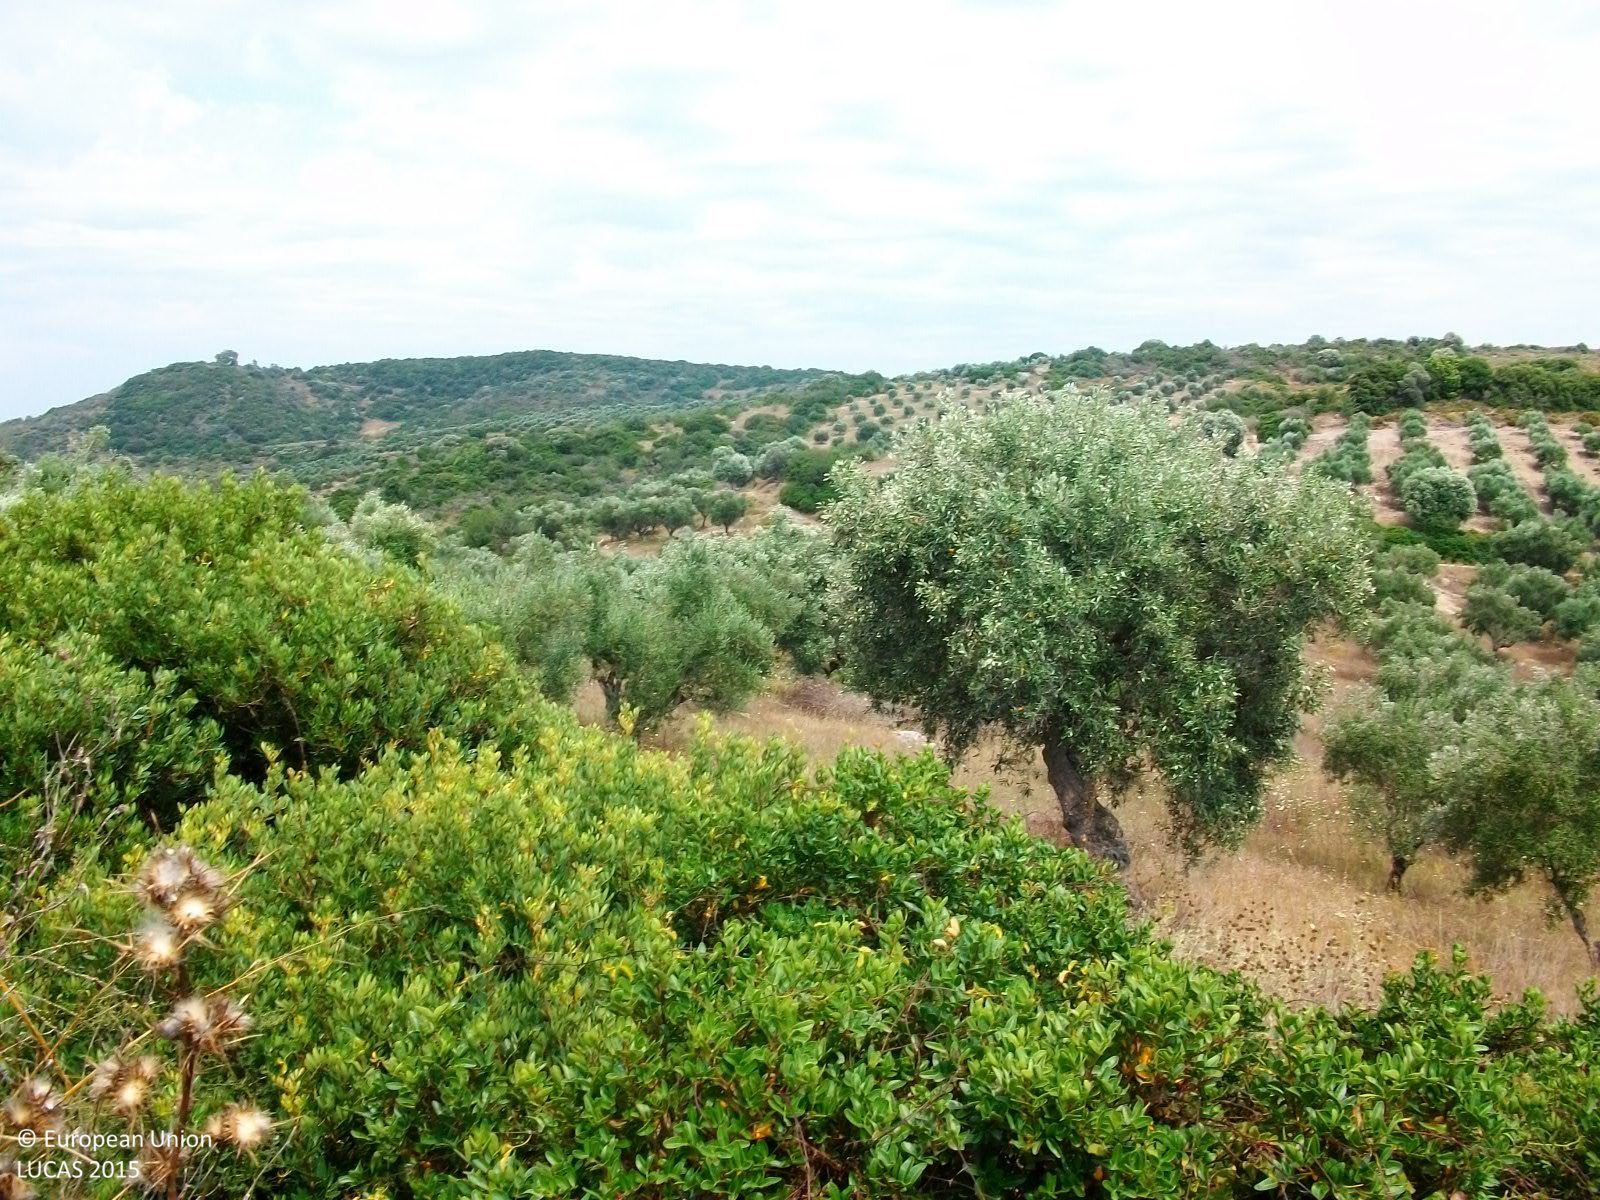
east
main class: Cropland
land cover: Olive groves
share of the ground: > 75 %
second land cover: Spontaneously vegetated surfaces
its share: > 75 %
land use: Agriculture (excluding fallow land and kitchen gardens)
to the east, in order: Olive groves; Spontaneously vegetated surfaces; Shruby margins; Olive groves; Shruby margins; Dry stone walls; Olive groves; Grass margins; Tracks; Grass margins; Olive groves
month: July
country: GR
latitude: 36.8393
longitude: 21.8469
